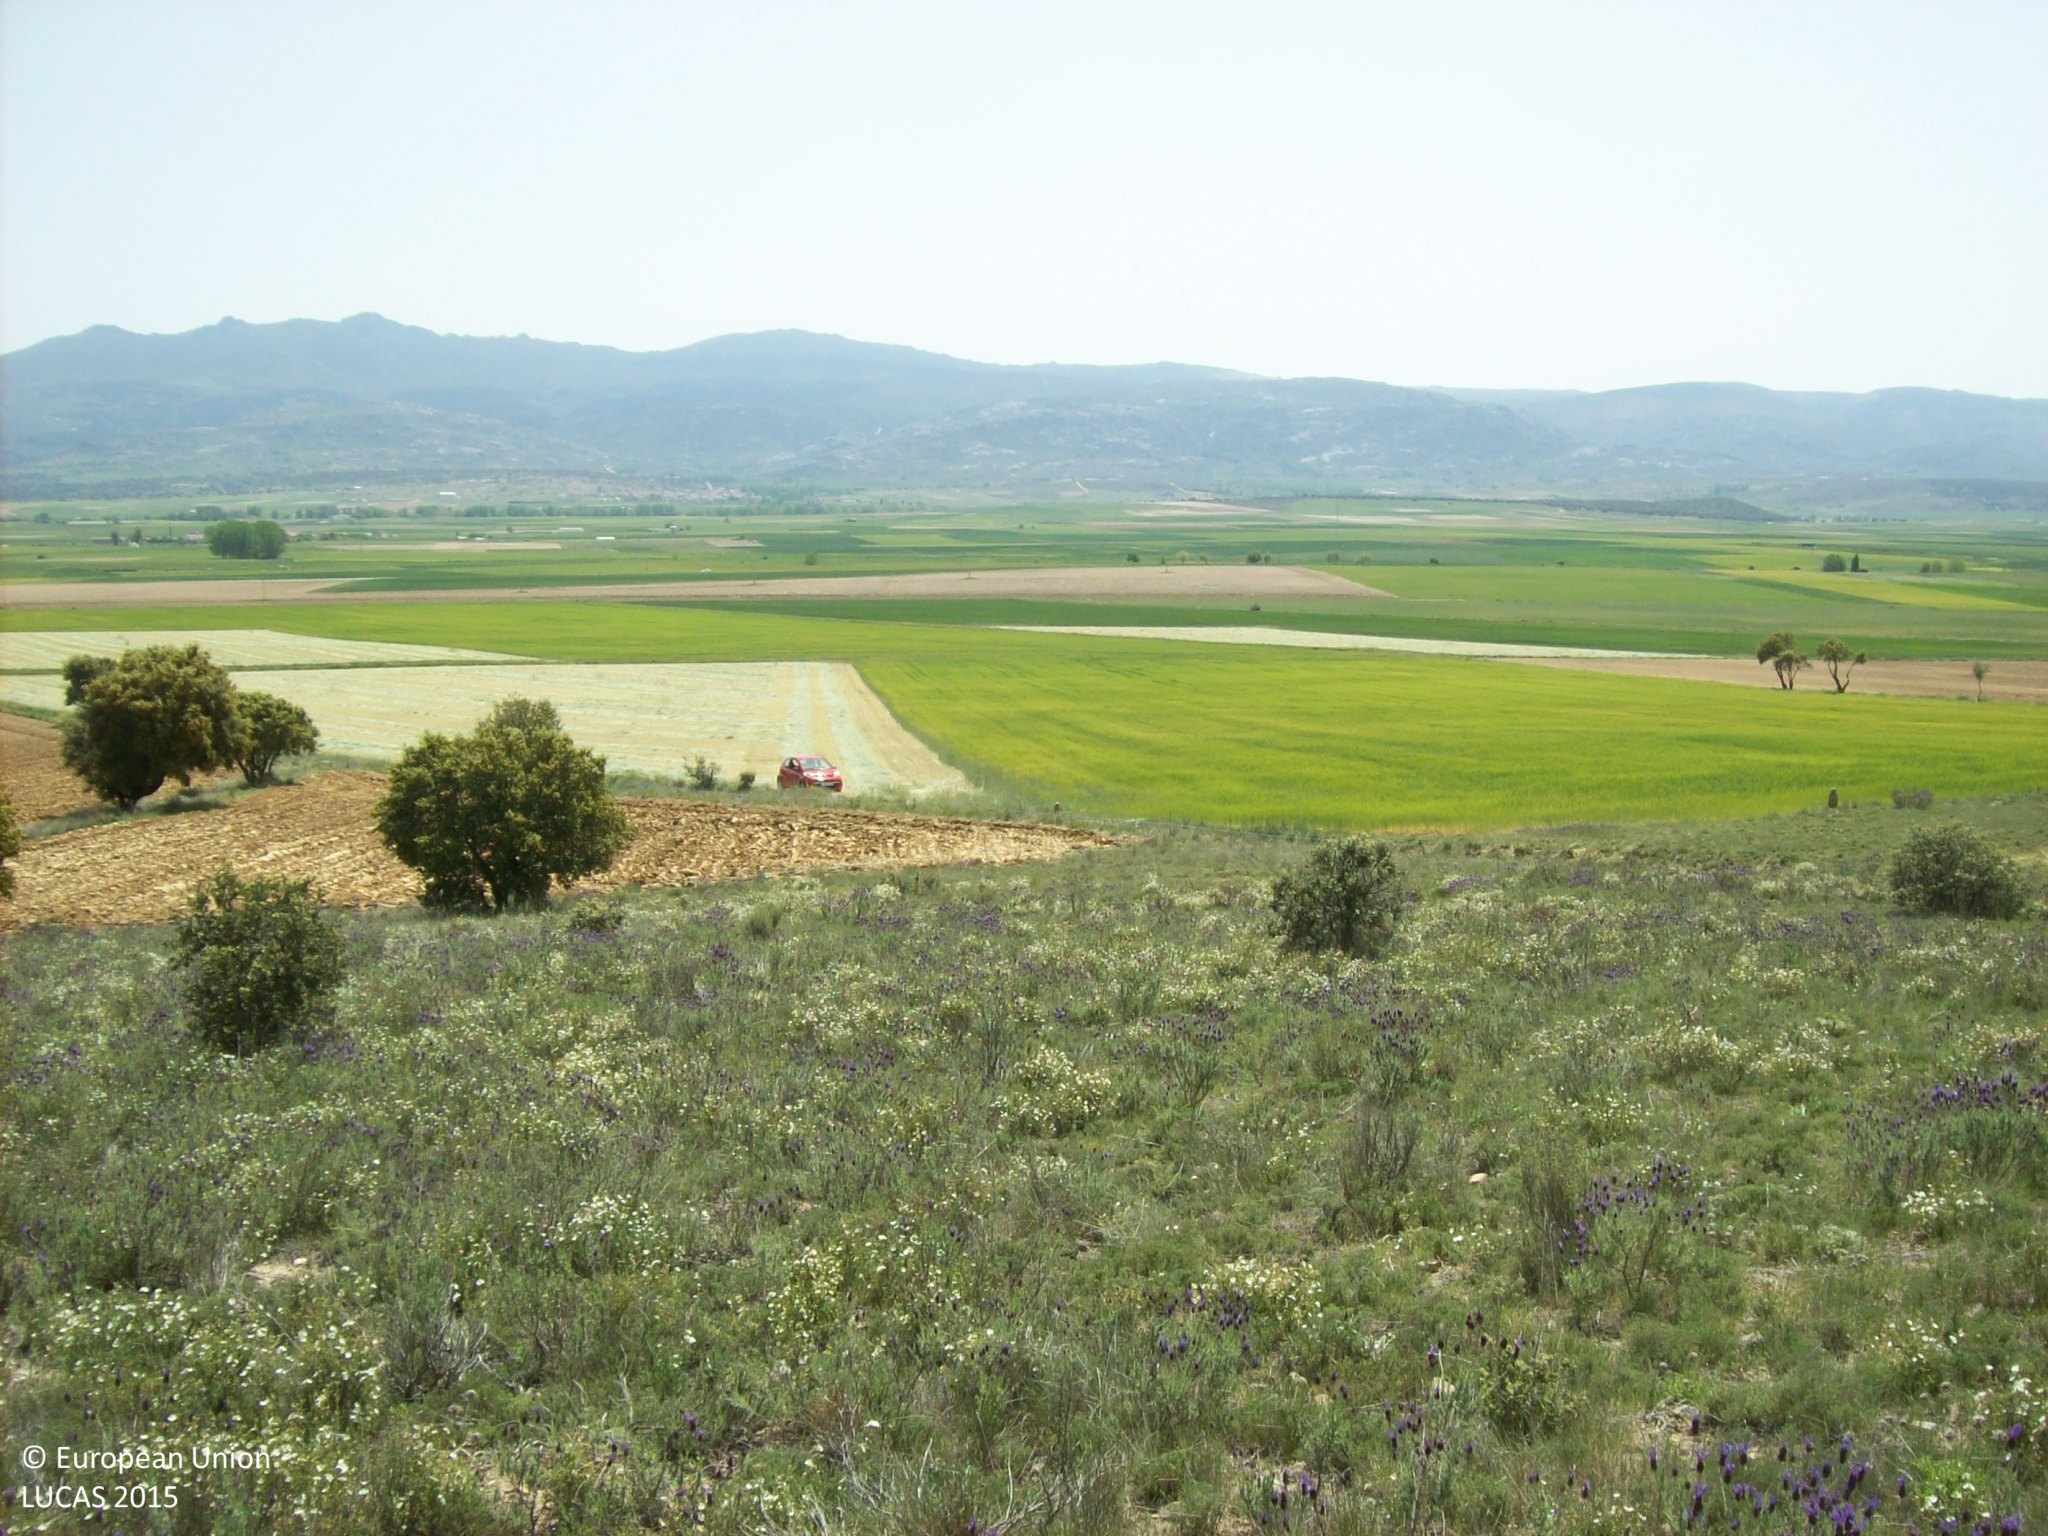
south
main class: Woodland
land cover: Broadleaved woodland
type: broadleaved evergreen forest
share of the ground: 50 - 75 %
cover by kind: shrubs 60 %, unconsolidated bare surface 20 %, broadleaved forest trees 10 %, herbaceous plants 10 %
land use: Semi-natural and natural areas not in use
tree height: < 5 m
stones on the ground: < 10 %
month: May
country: ES
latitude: 40.6072
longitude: -4.9144
